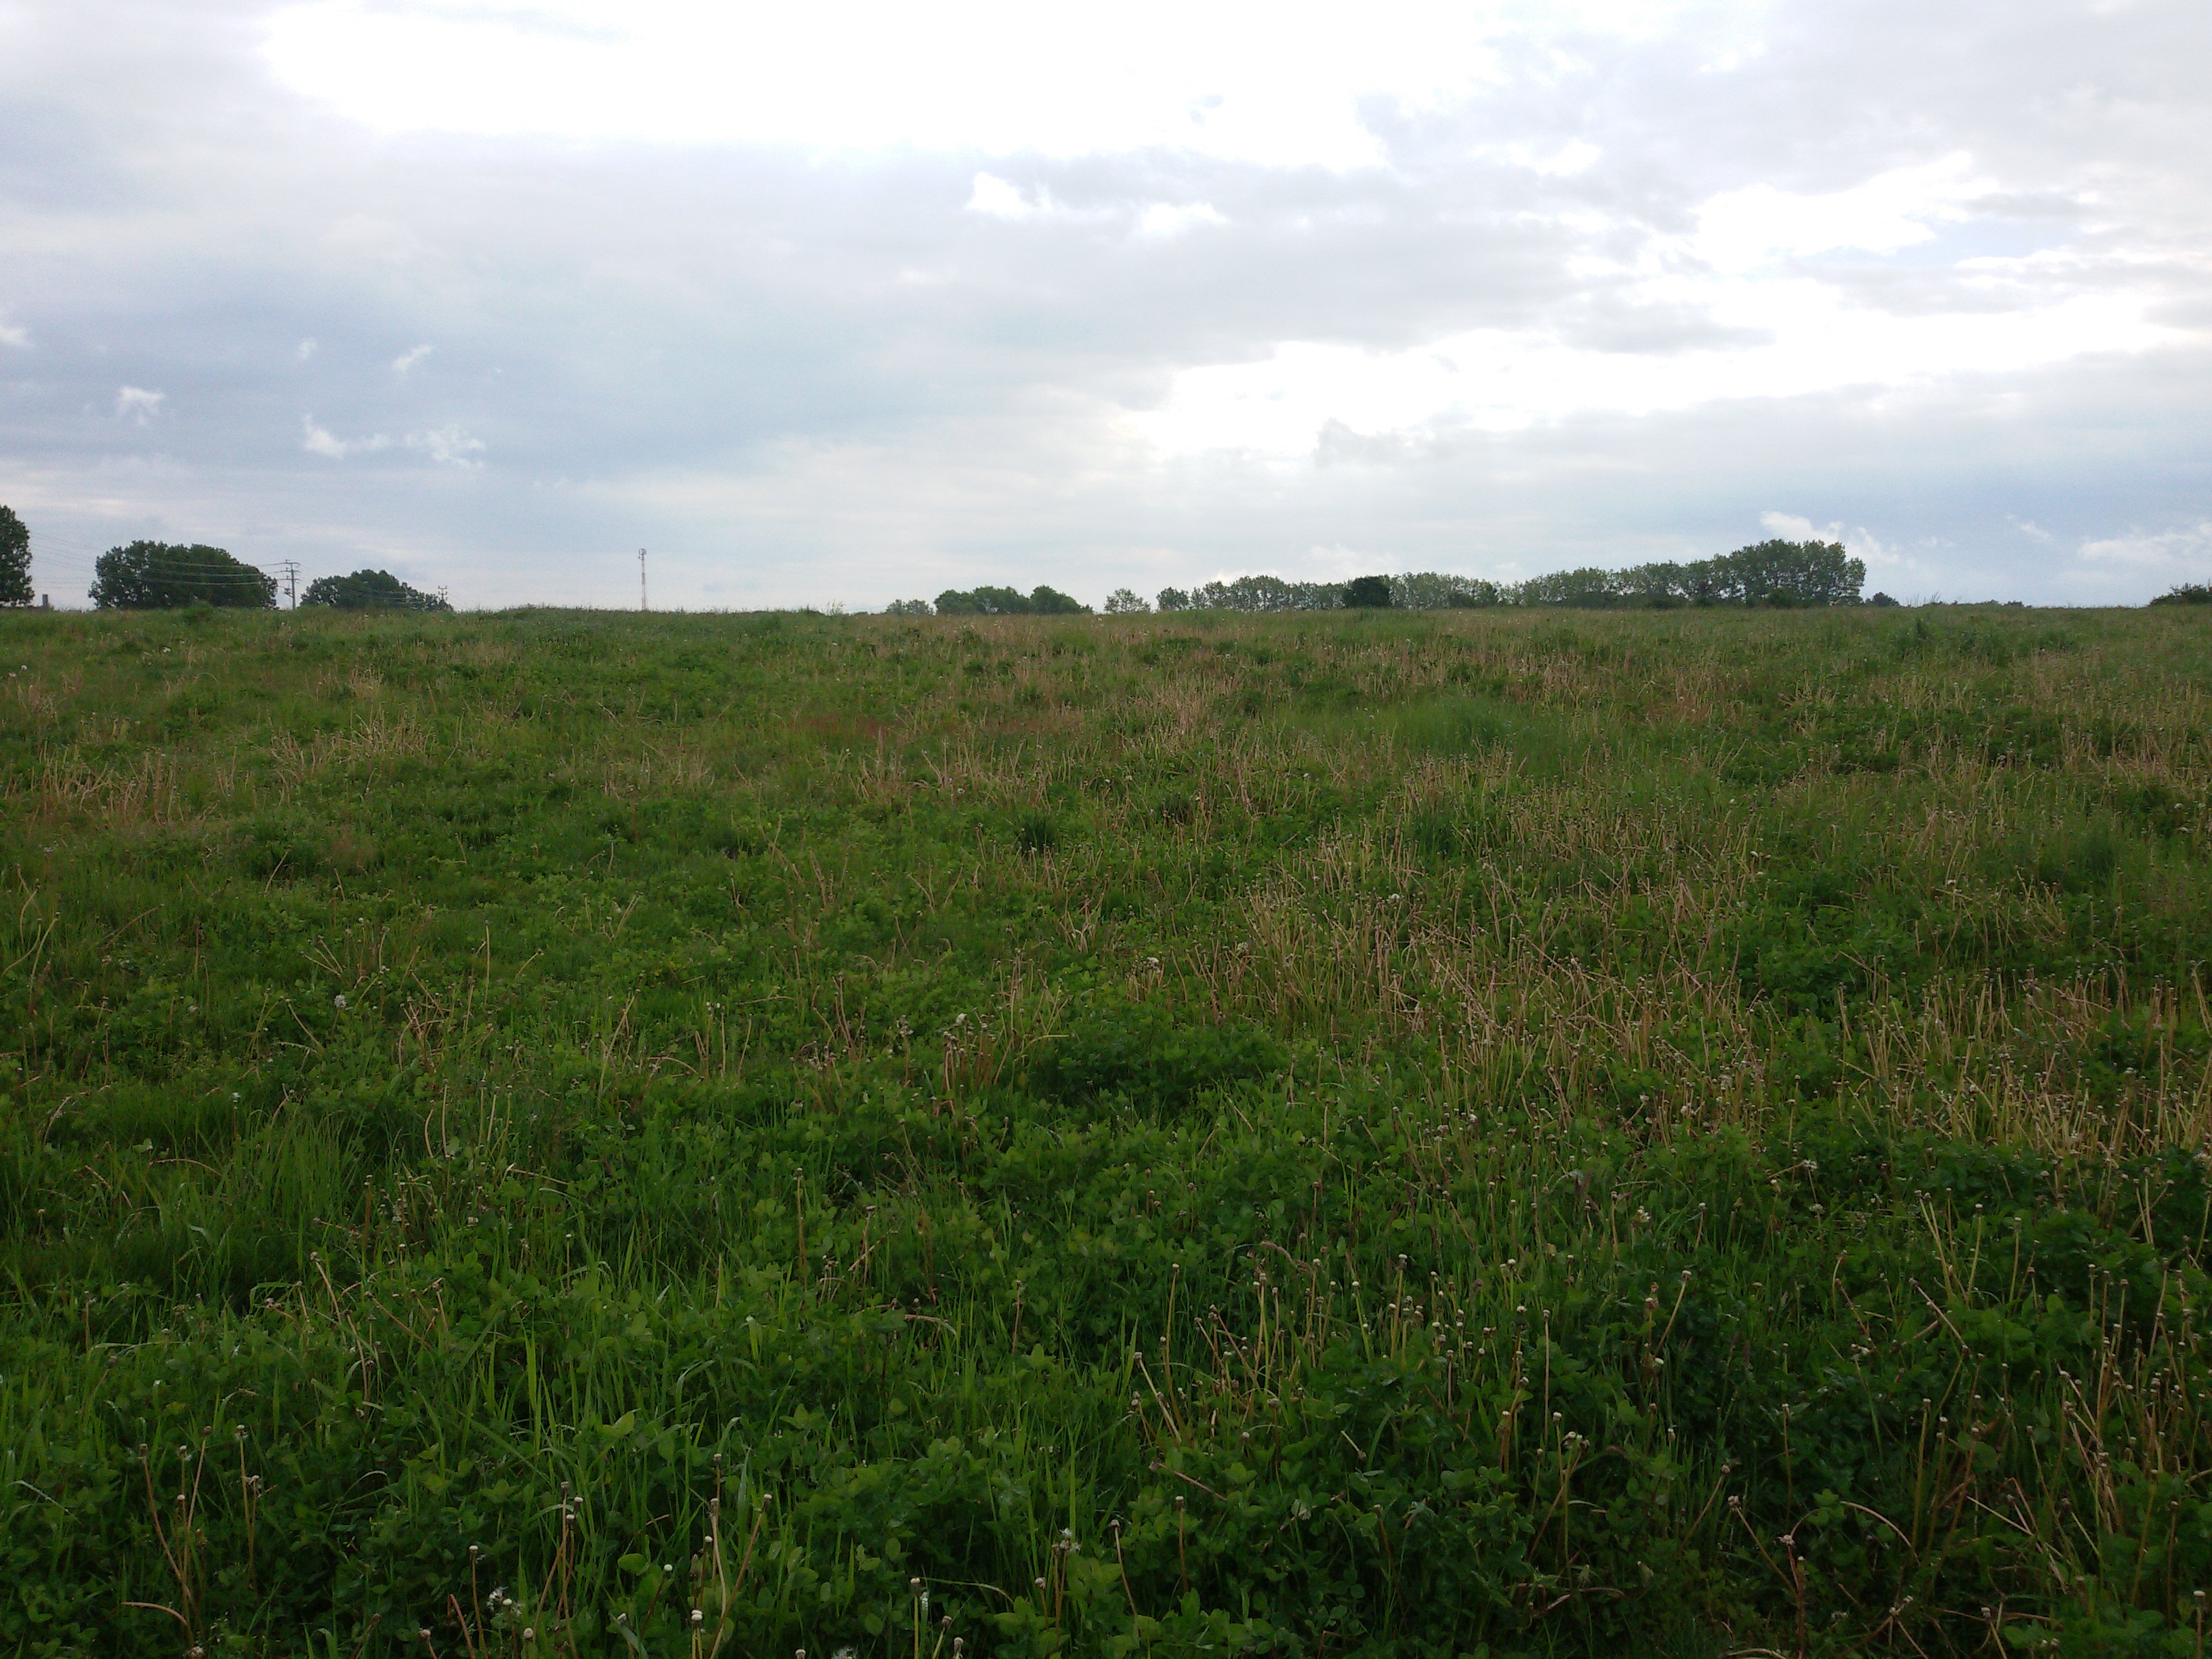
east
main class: Grassland
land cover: Grassland without tree/shrub cover
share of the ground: > 75 %
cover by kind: herbaceous plants 100 %
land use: Agriculture (excluding fallow land and kitchen gardens)
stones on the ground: < 10 %
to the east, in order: Grassland without tree/shrub cover
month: May
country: PL
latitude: 53.2605
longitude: 14.6037
